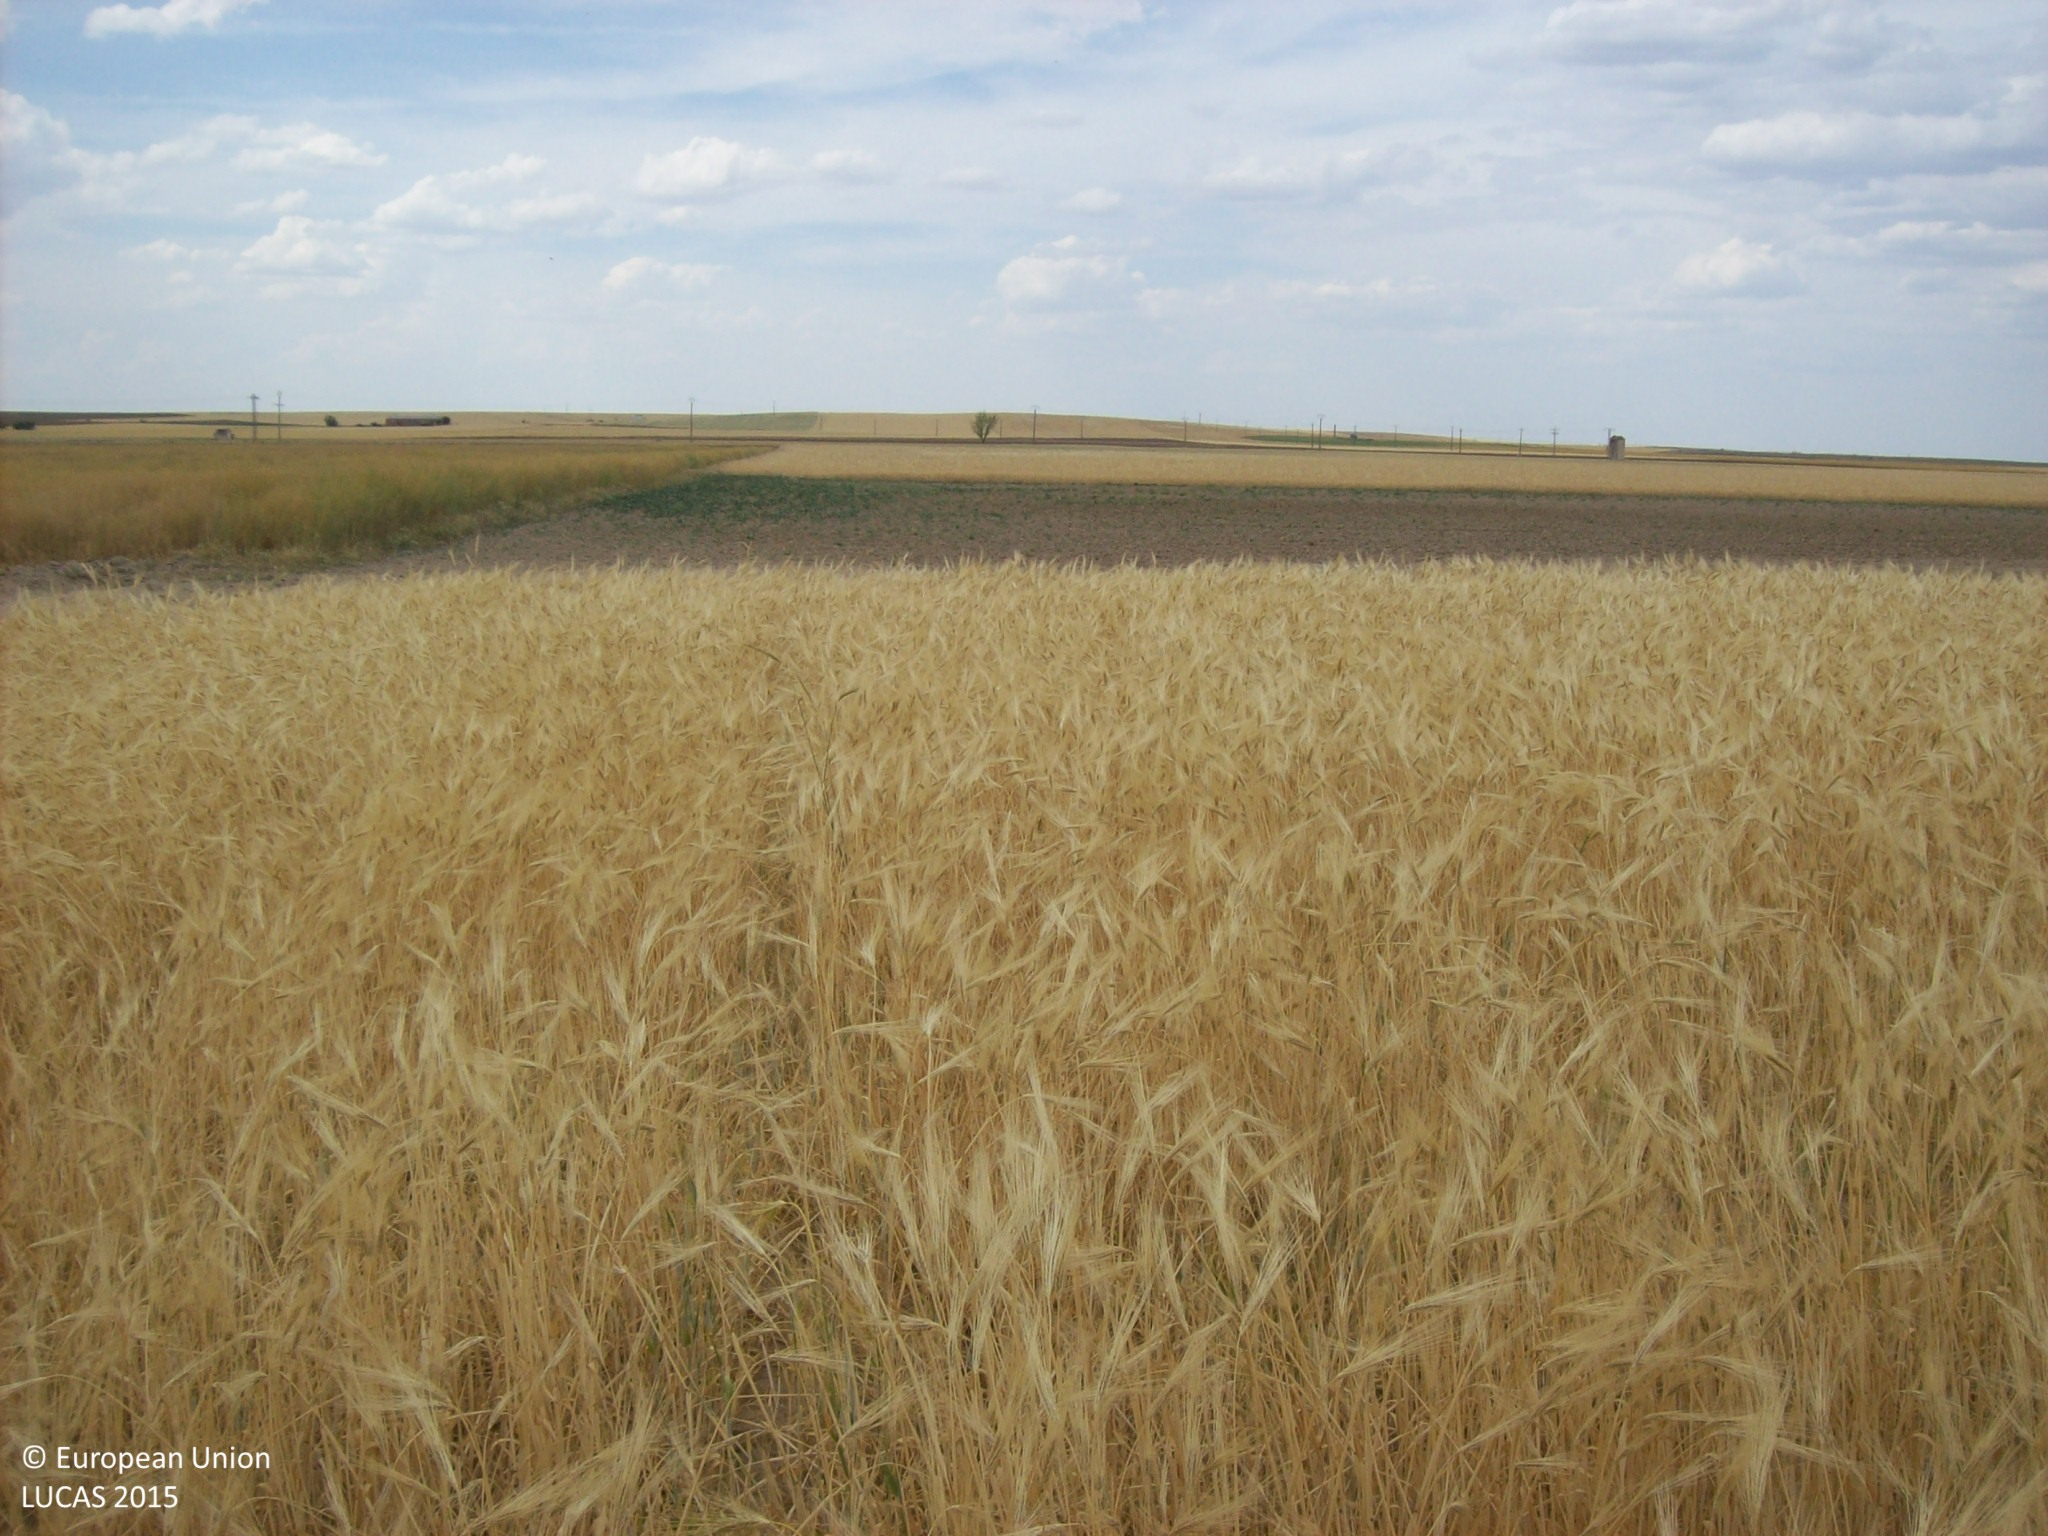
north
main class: Cropland
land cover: Barley
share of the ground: > 75 %
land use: Agriculture (excluding fallow land and kitchen gardens)
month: June
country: ES
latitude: 41.0849
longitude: -5.0301
